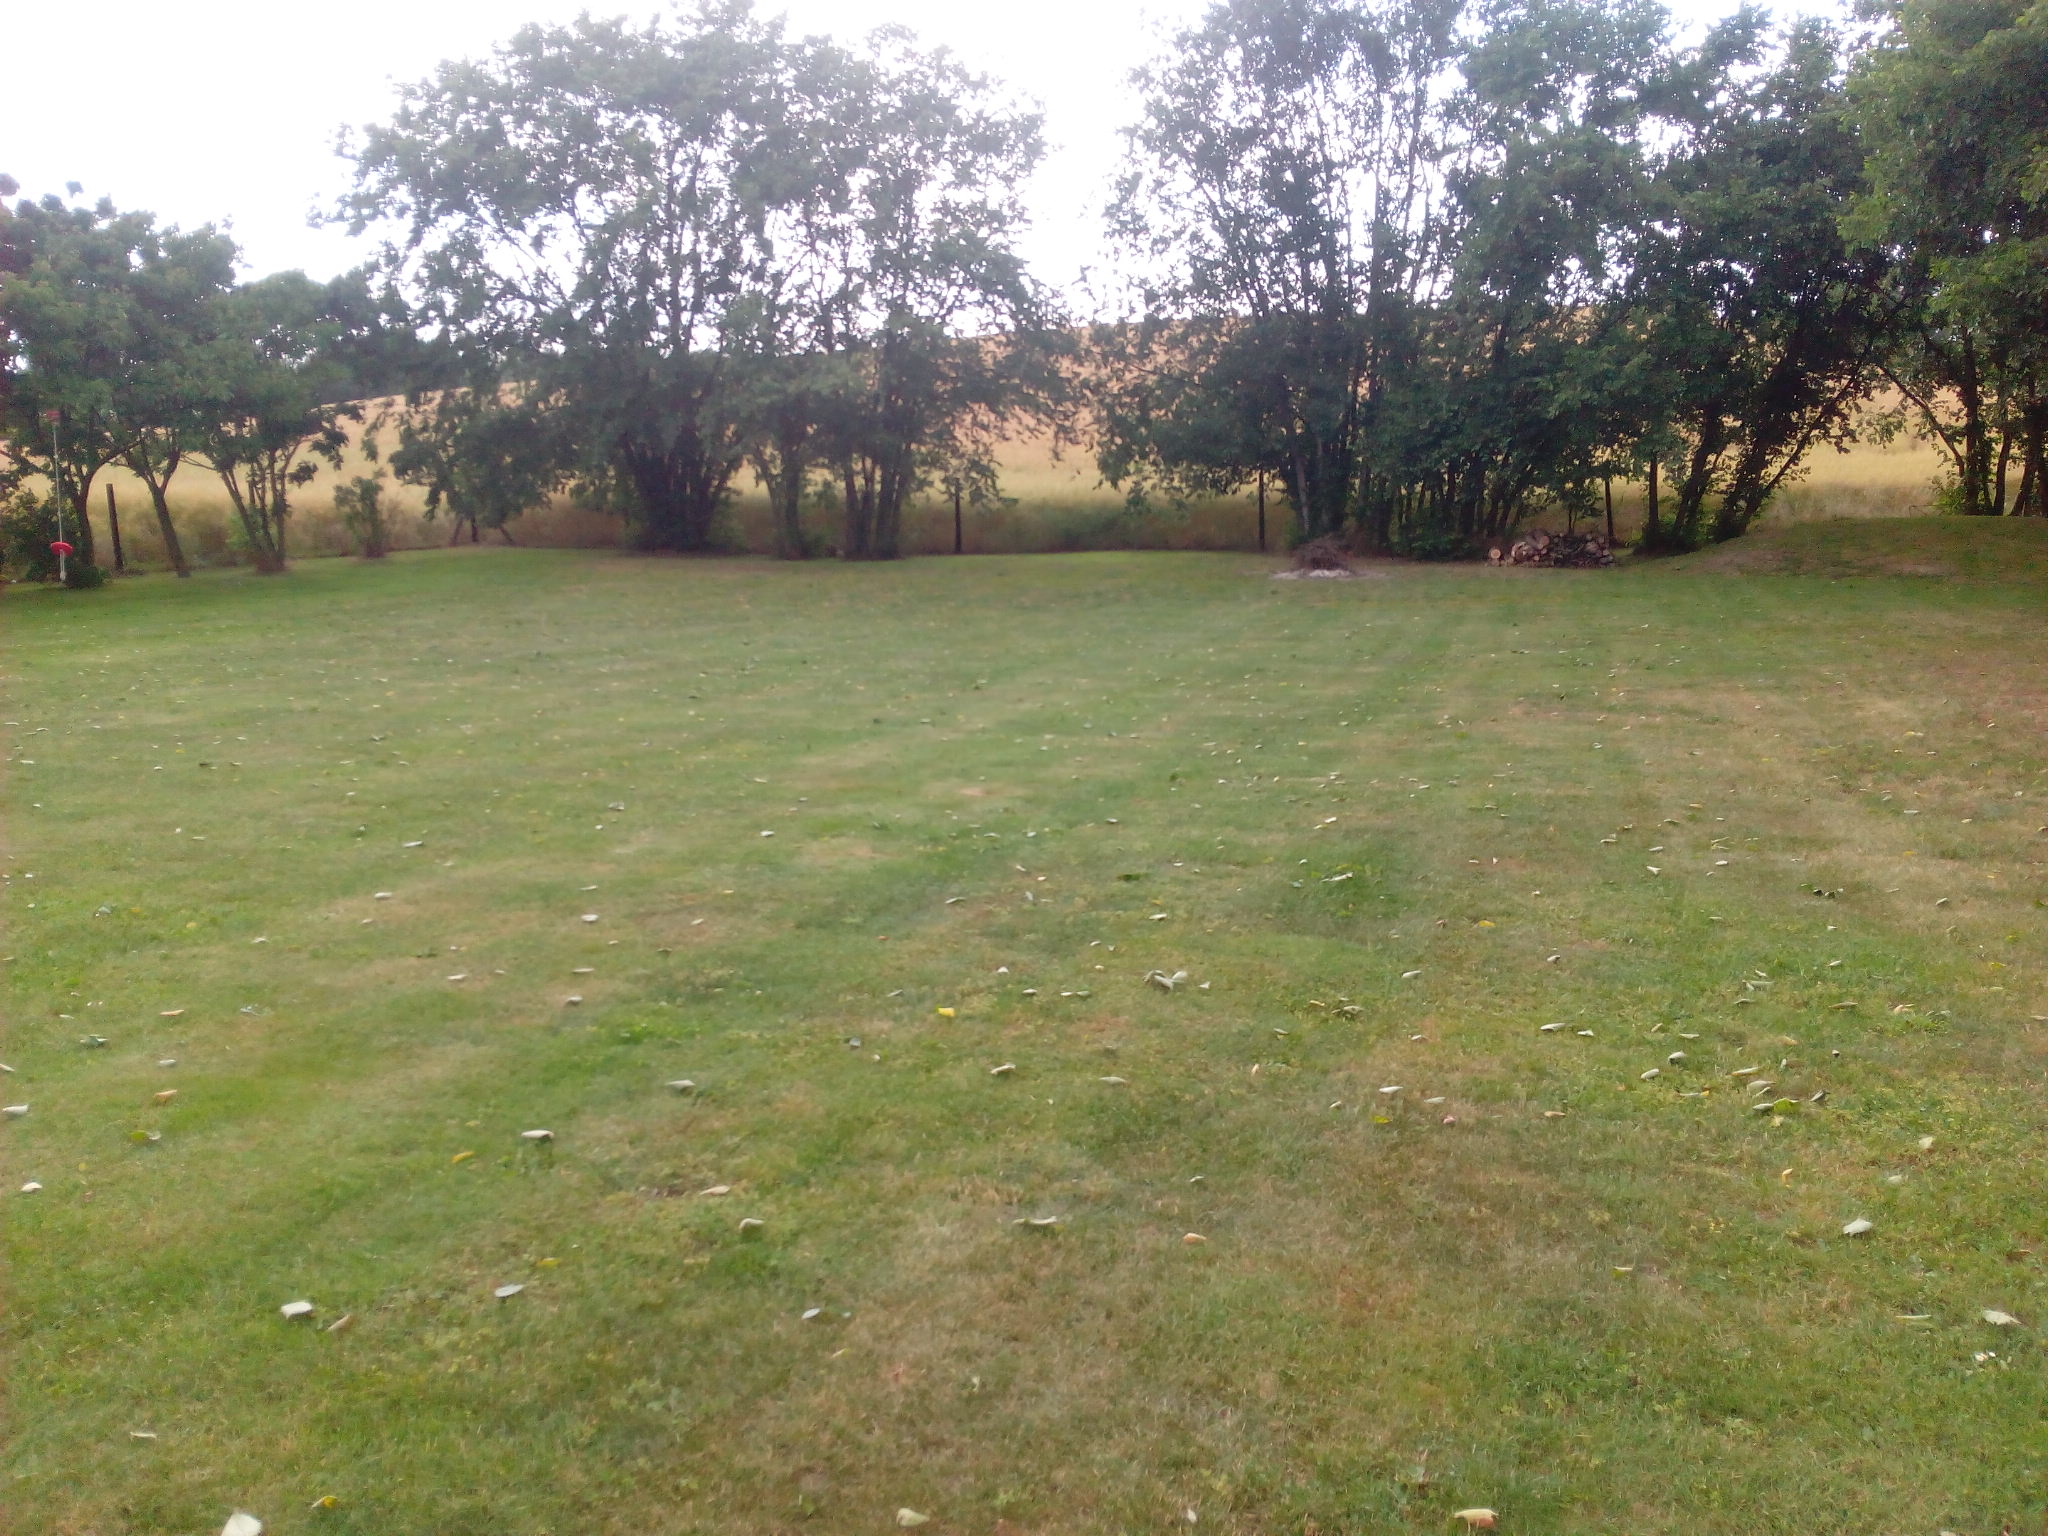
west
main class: Grassland
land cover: Grassland with sparse tree/shrub cover
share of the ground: > 75 %
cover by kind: herbaceous plants 95 %, broadleaved forest trees 5 %
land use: Residential
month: July
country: DE
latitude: 53.3264
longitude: 14.2798
